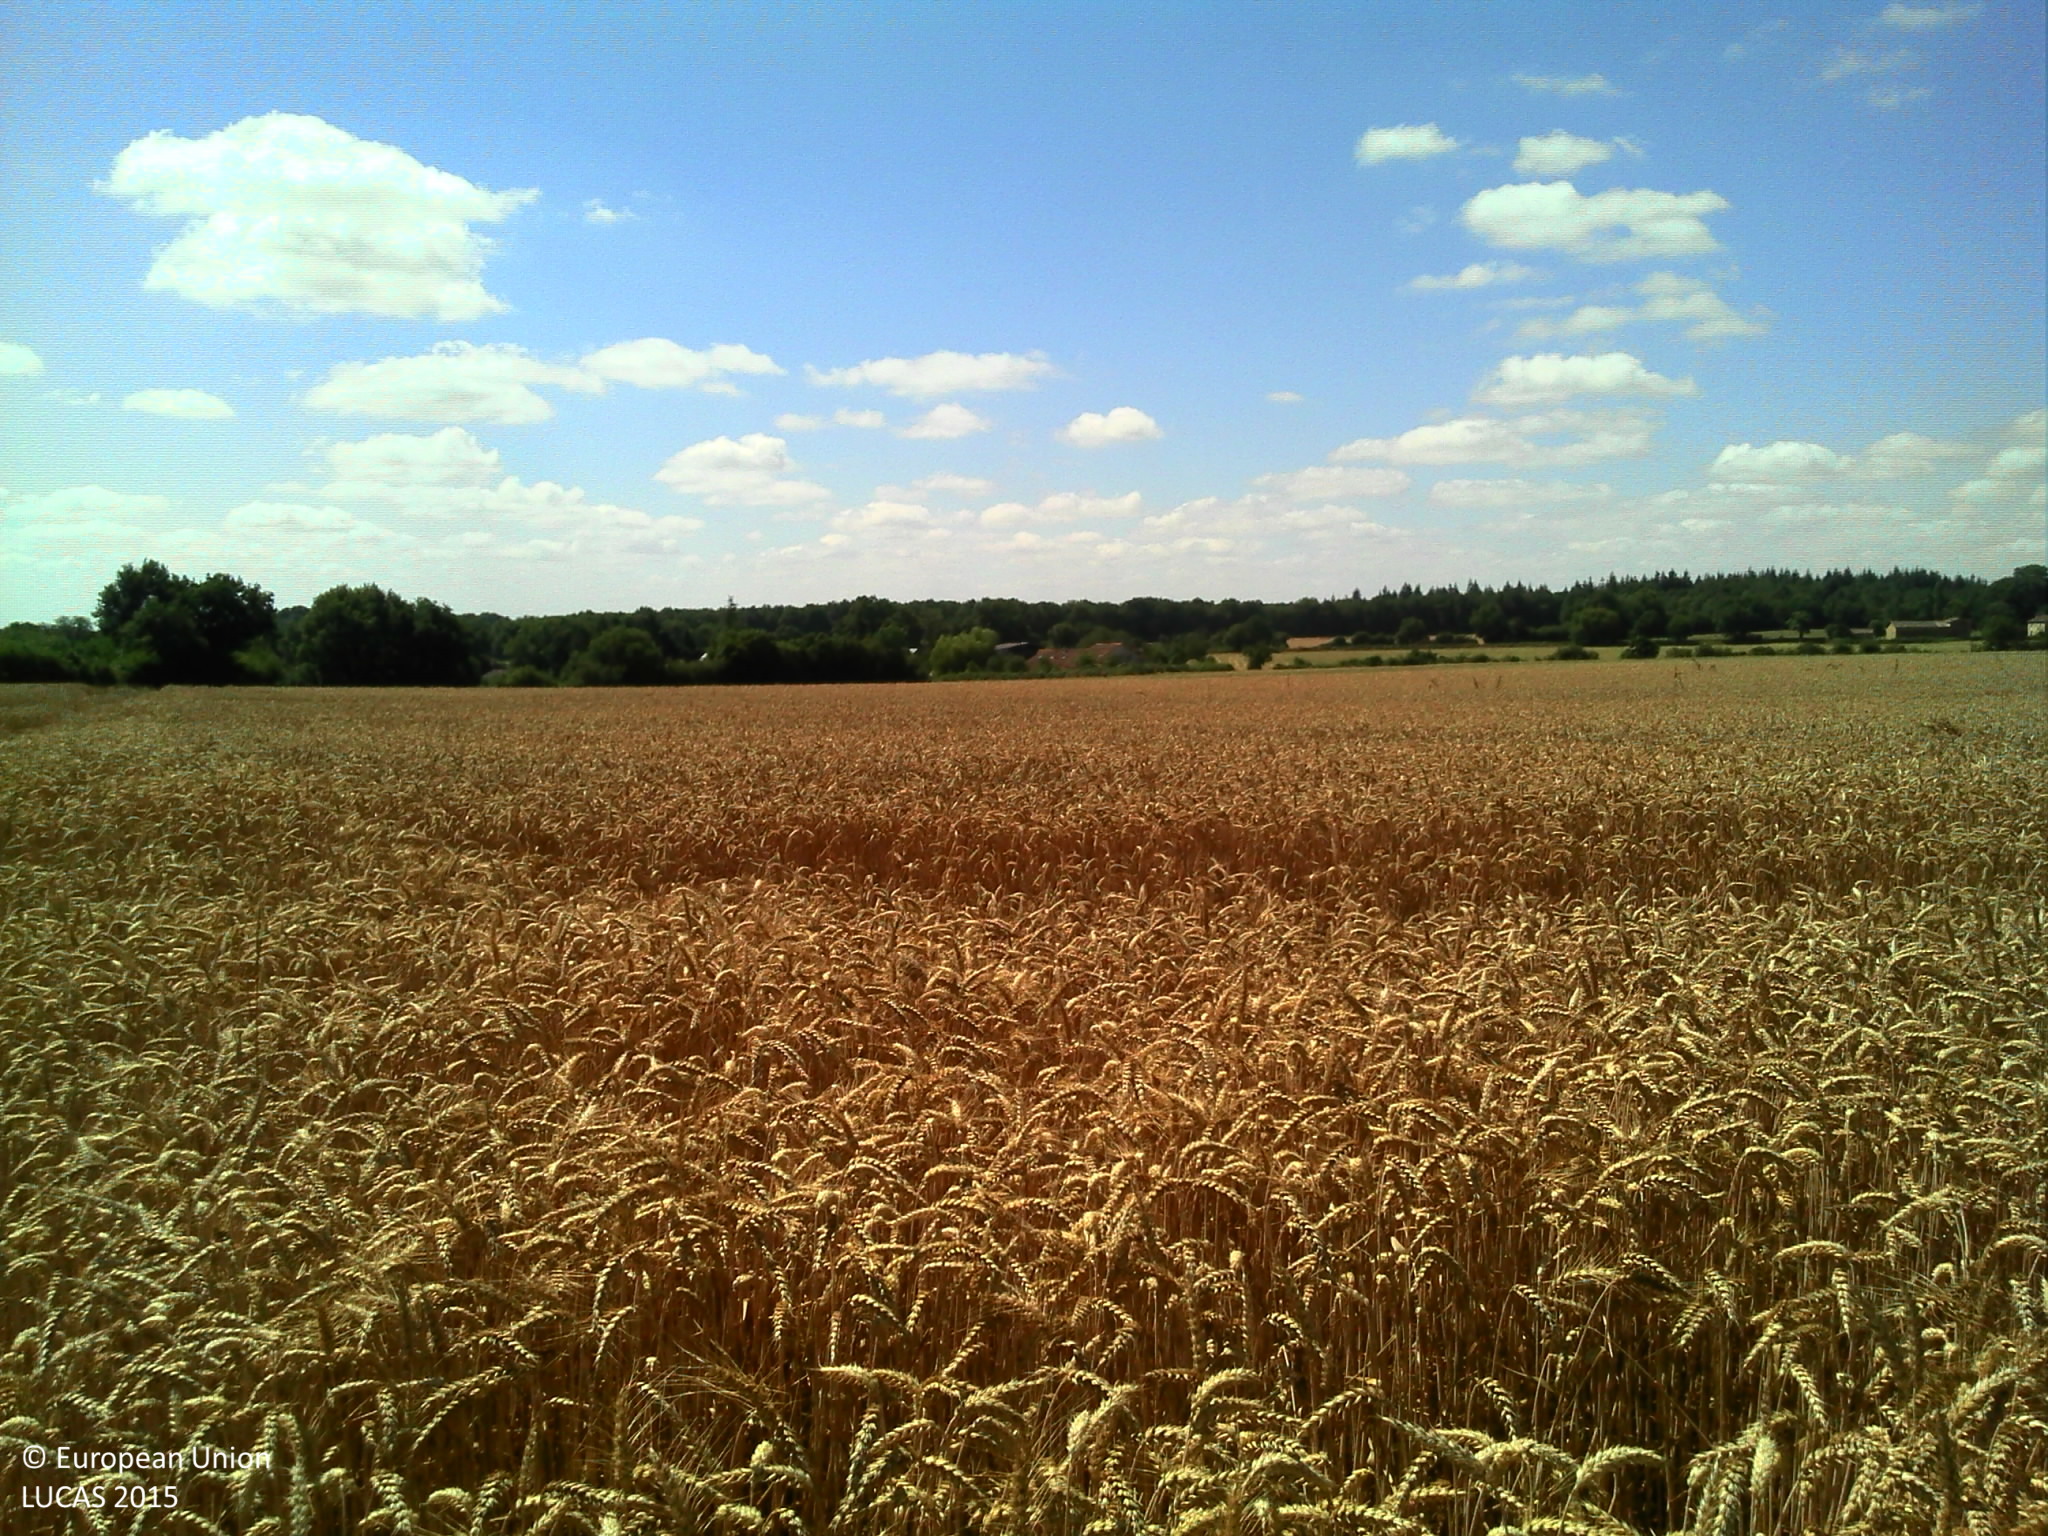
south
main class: Cropland
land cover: Common wheat
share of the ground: > 75 %
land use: Agriculture (excluding fallow land and kitchen gardens)
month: July
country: FR
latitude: 46.5874
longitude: 0.1781
